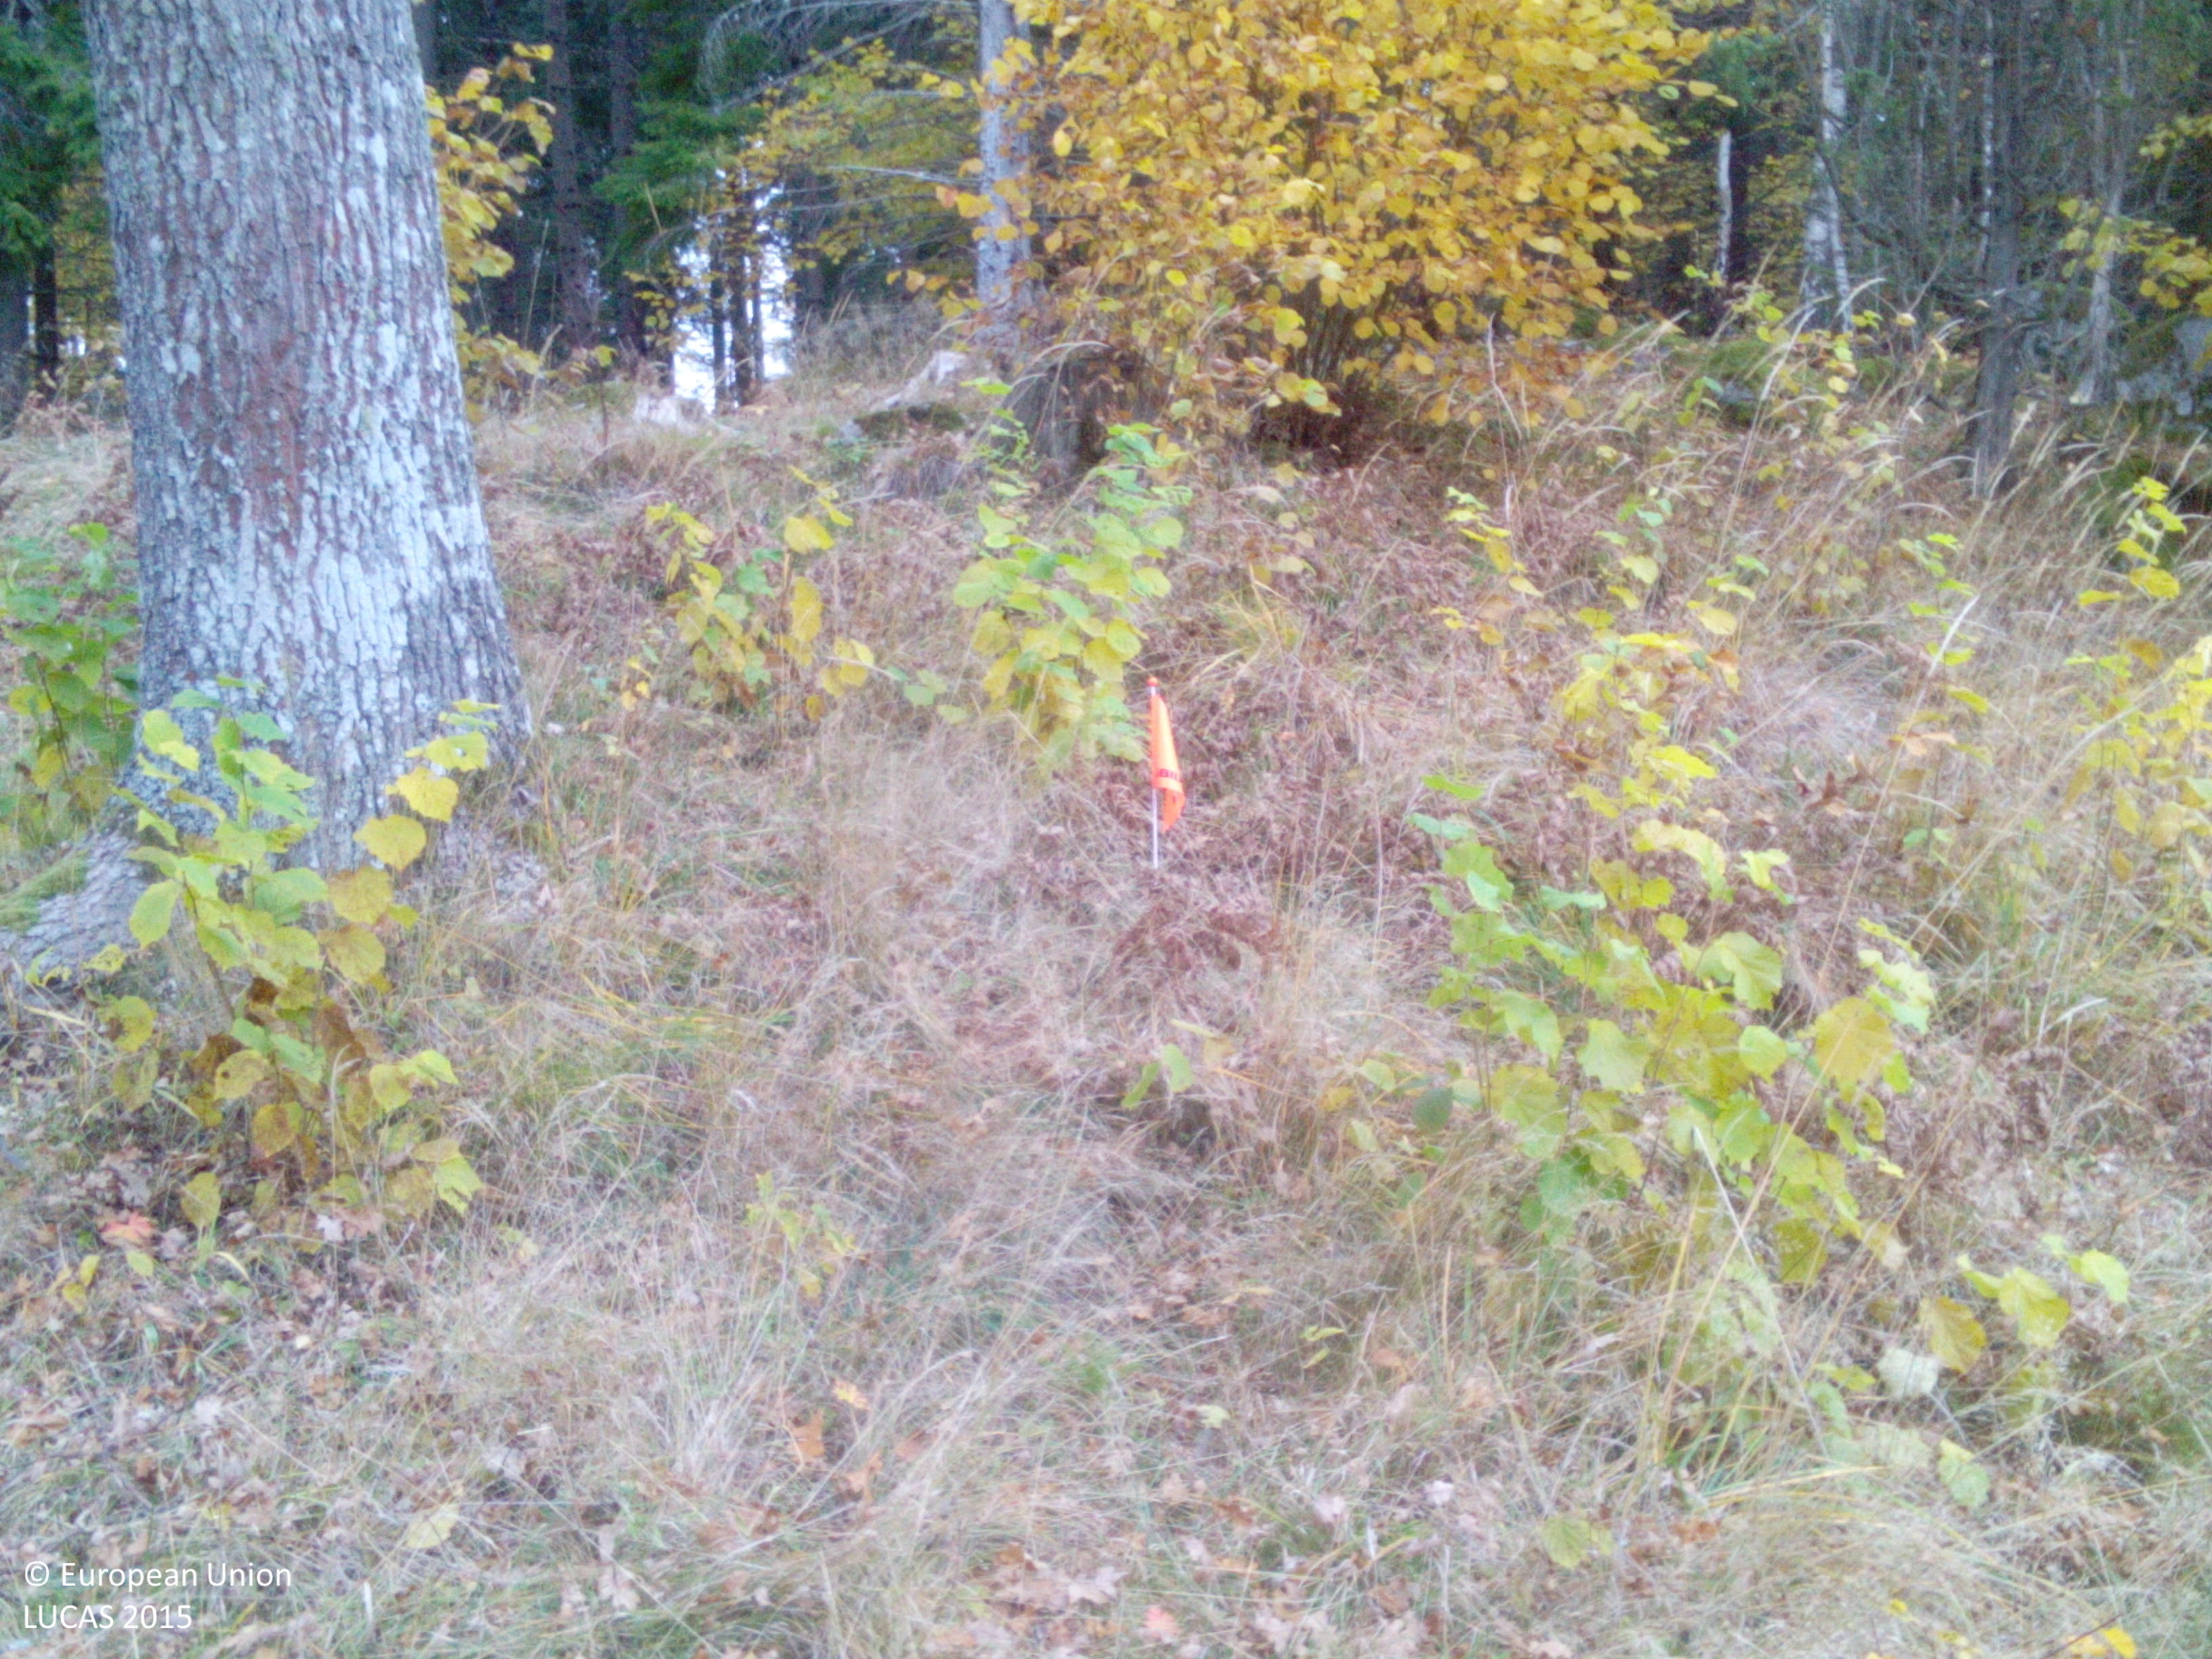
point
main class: Woodland
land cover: Broadleaved woodland
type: hemiboreal forest and nemoral coniferous forest and mixed broadleaved-coniferous forest
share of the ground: 25 - 50 %
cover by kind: herbaceous plants 60 %, broadleaved forest trees 40 %
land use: Agriculture (excluding fallow land and kitchen gardens)
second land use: Forestry
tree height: > 5 m
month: October
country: SE
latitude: 58.9985
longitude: 16.5568
